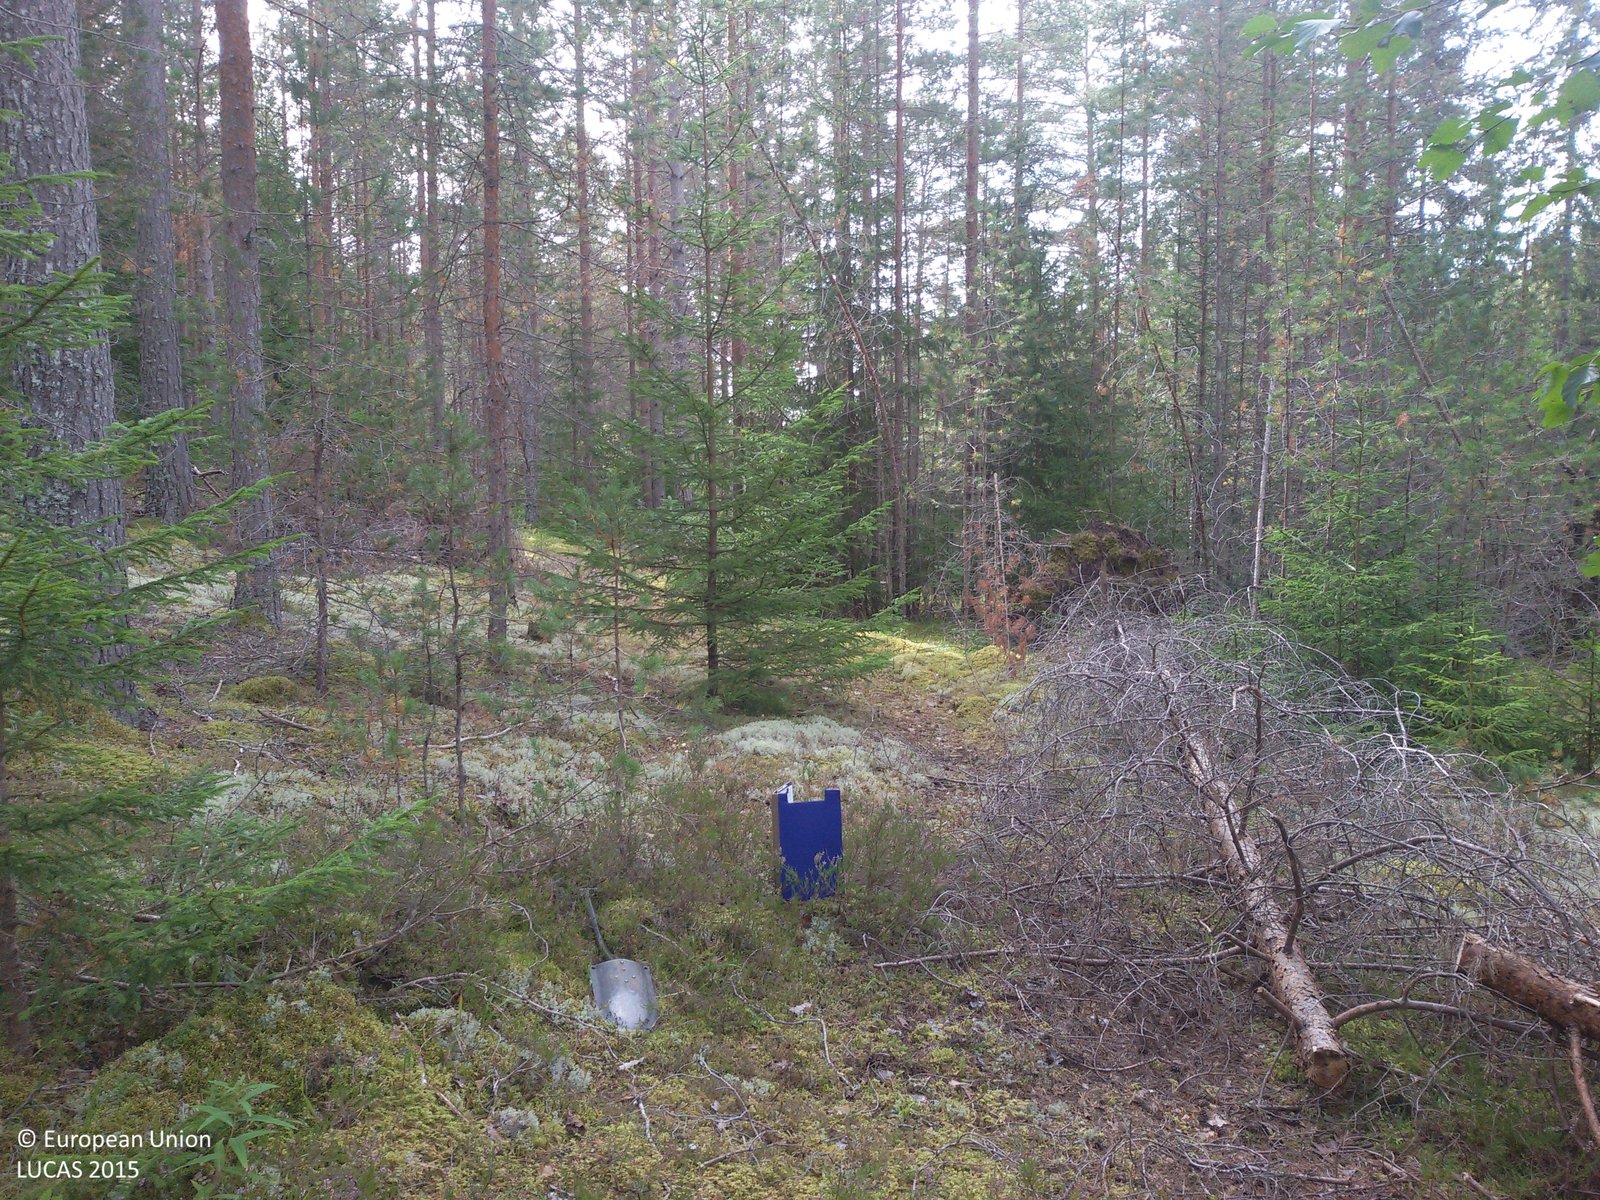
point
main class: Woodland
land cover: Pine dominated coniferous woodland
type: boreal forest
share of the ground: 50 - 75 %
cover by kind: coniferous forest trees 60 %, lichens and mosses 30 %, herbaceous plants 10 %
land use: Forestry
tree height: > 5 m
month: September
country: SE
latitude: 60.9853
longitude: 15.2535
